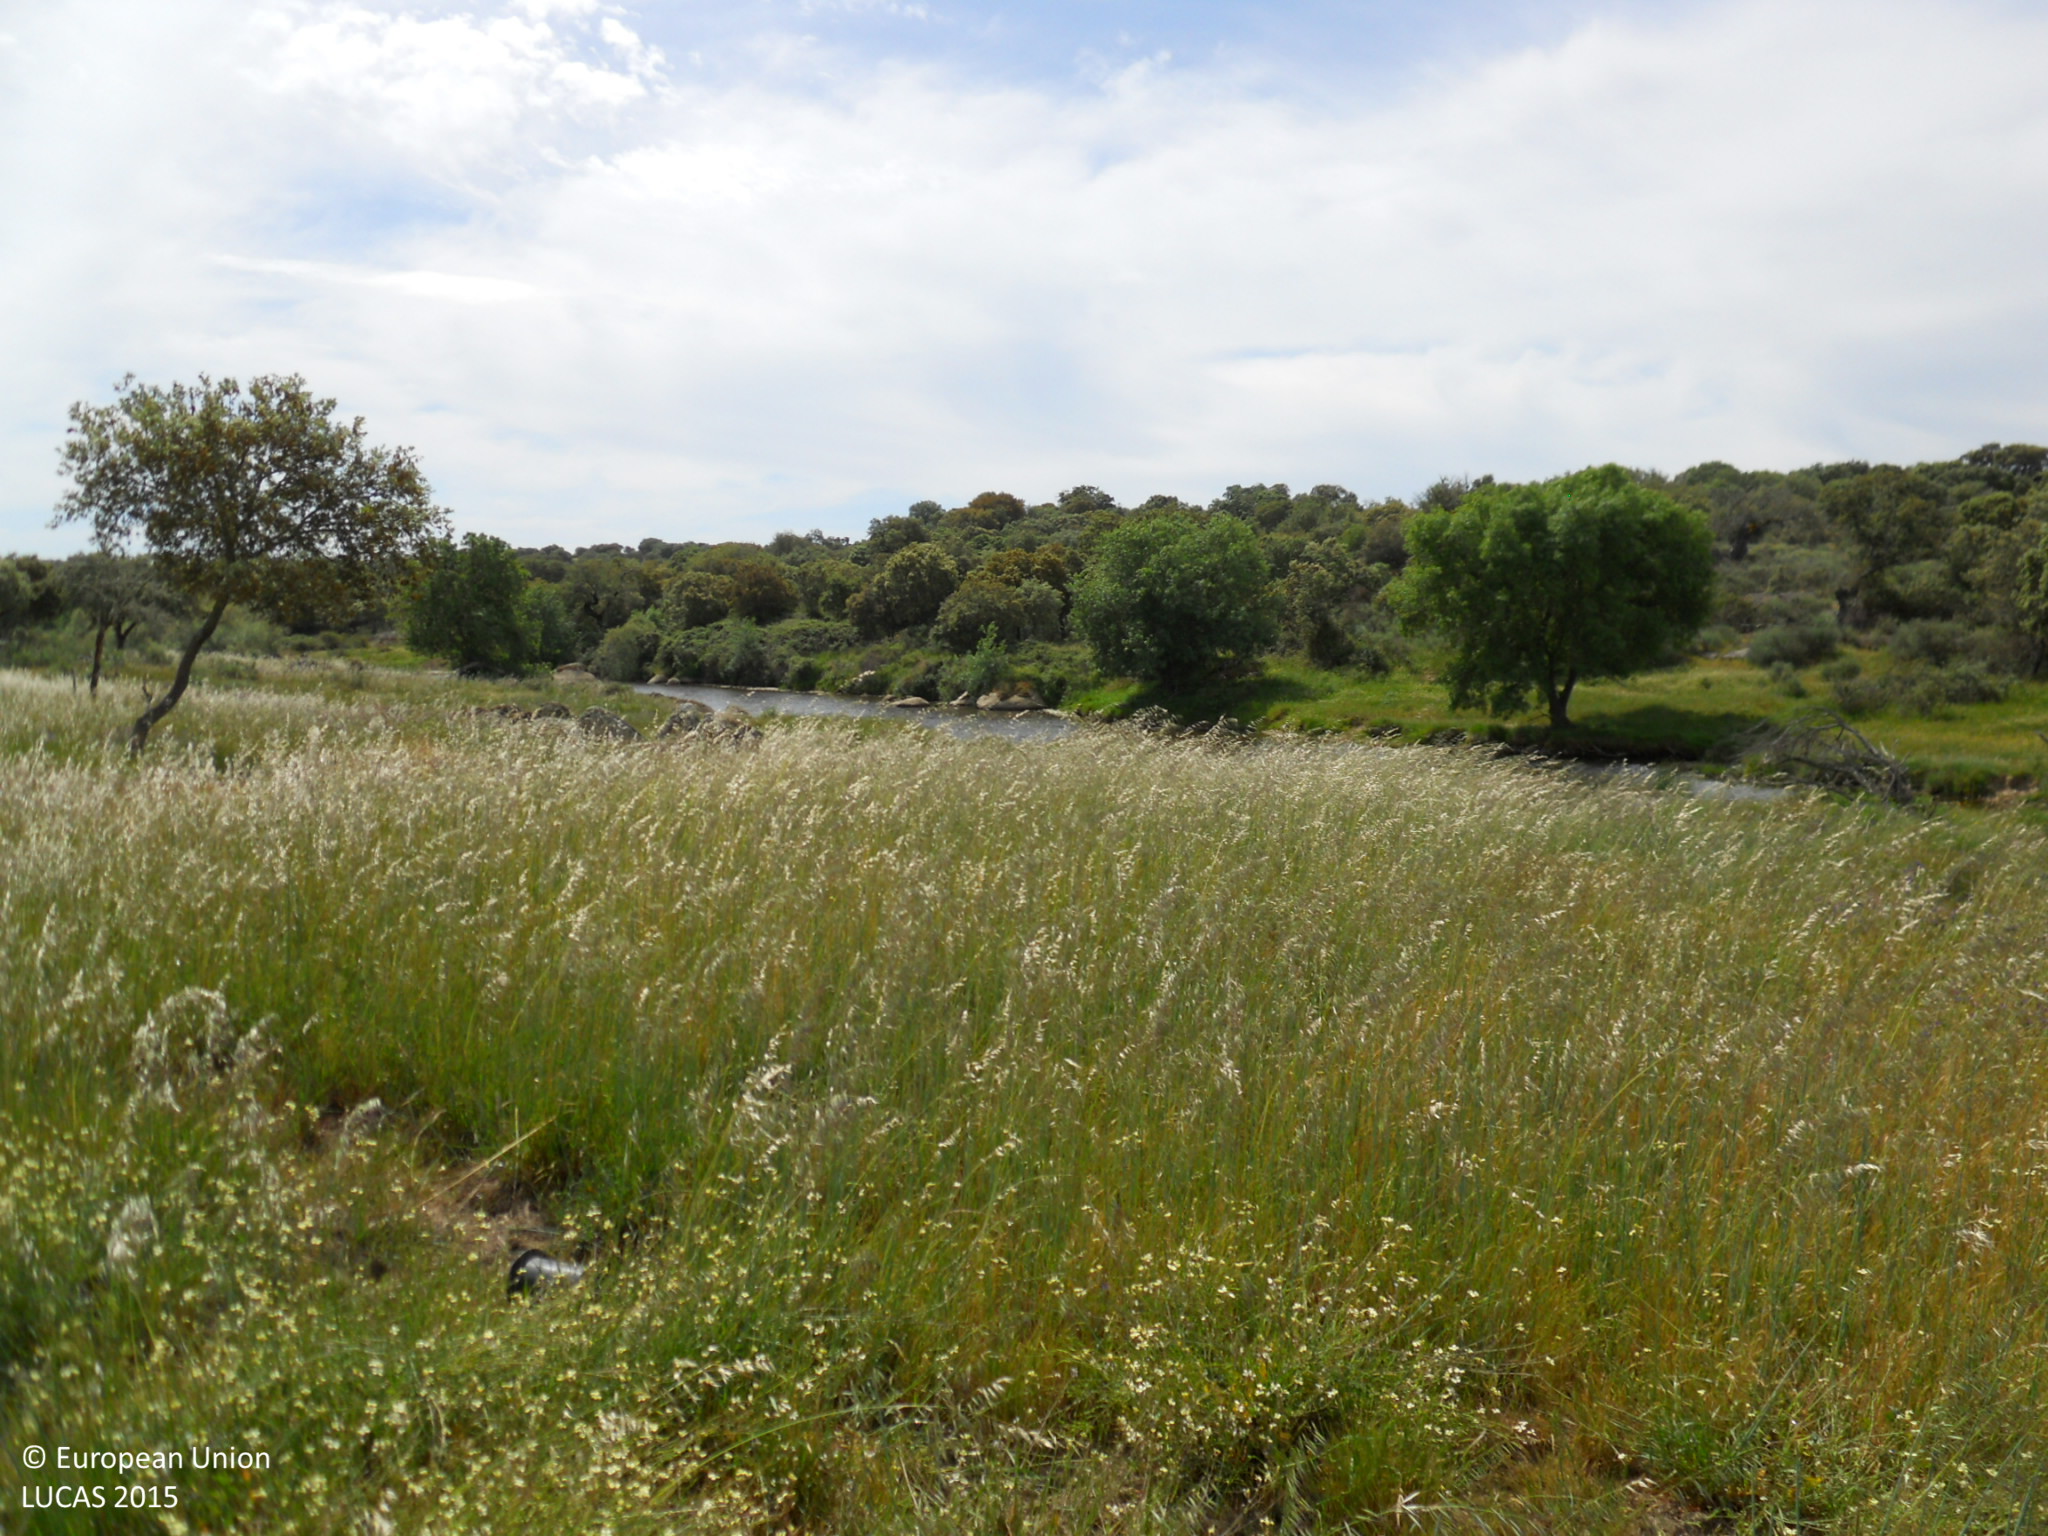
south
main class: Grassland
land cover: Grassland with sparse tree/shrub cover
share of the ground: > 75 %
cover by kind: herbaceous plants 95 %, broadleaved forest trees 5 %
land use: Semi-natural and natural areas not in use
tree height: > 5 m
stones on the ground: < 10 %
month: April
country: ES
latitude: 39.3050
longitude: -6.9028
